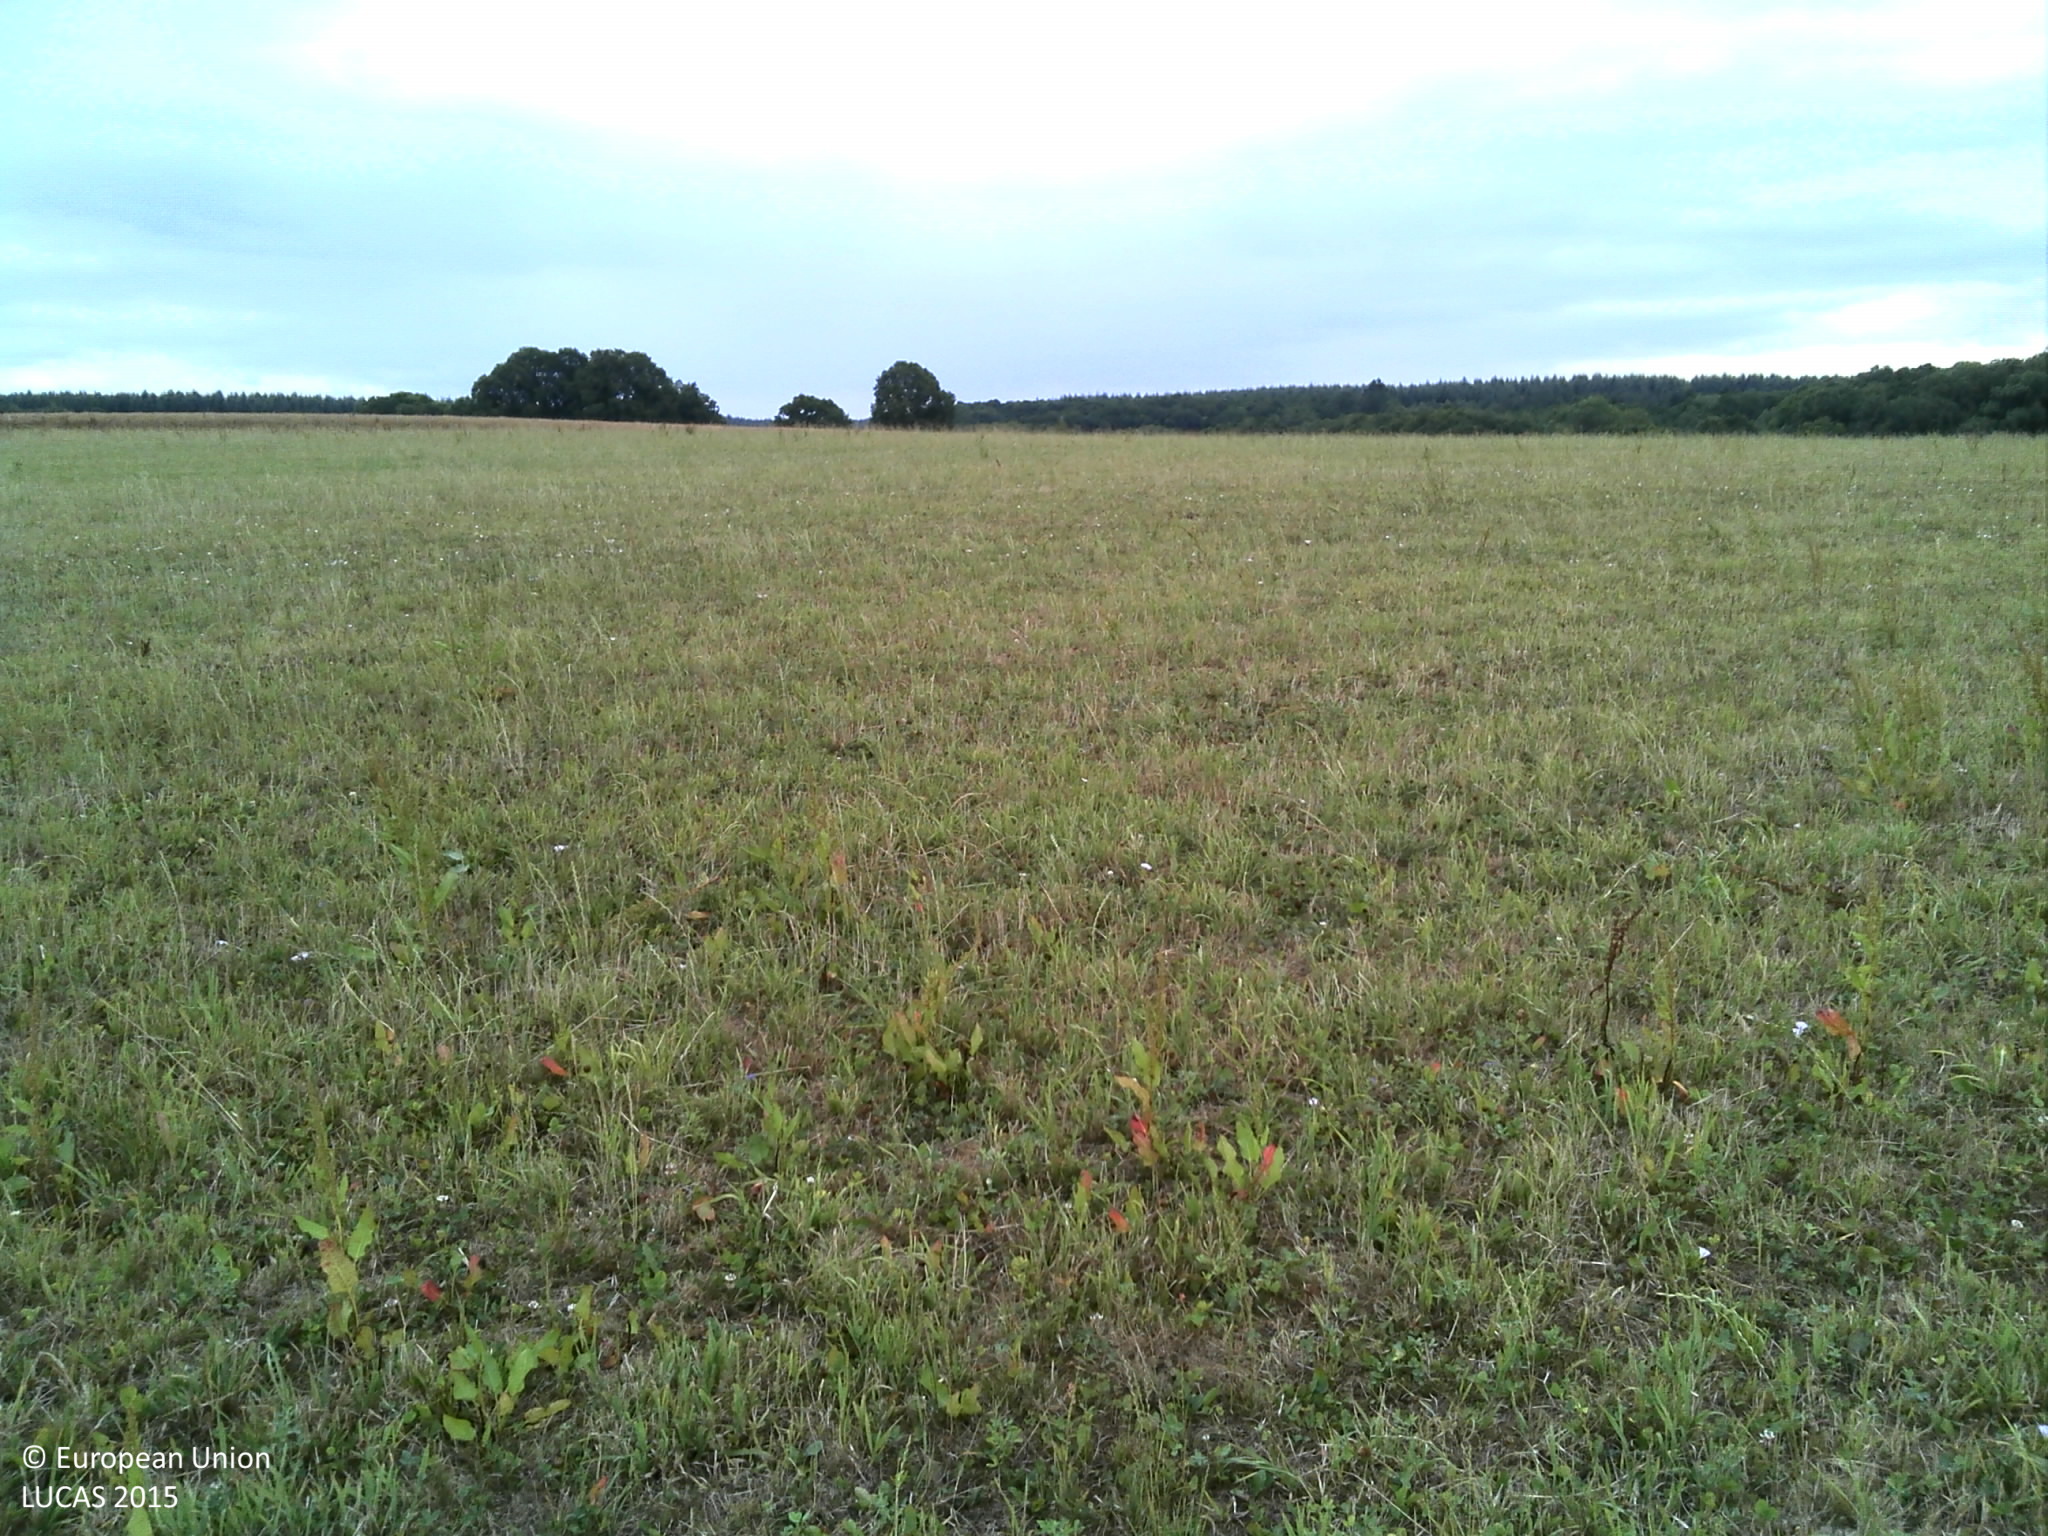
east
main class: Grassland
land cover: Grassland without tree/shrub cover
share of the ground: > 75 %
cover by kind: herbaceous plants 100 %
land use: Agriculture (excluding fallow land and kitchen gardens)
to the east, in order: Grassland without tree/shrub cover; Fences; Grassland without tree/shrub cover; Fences; Rape and turnip rape
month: July
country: FR
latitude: 49.2221
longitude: 4.8761
